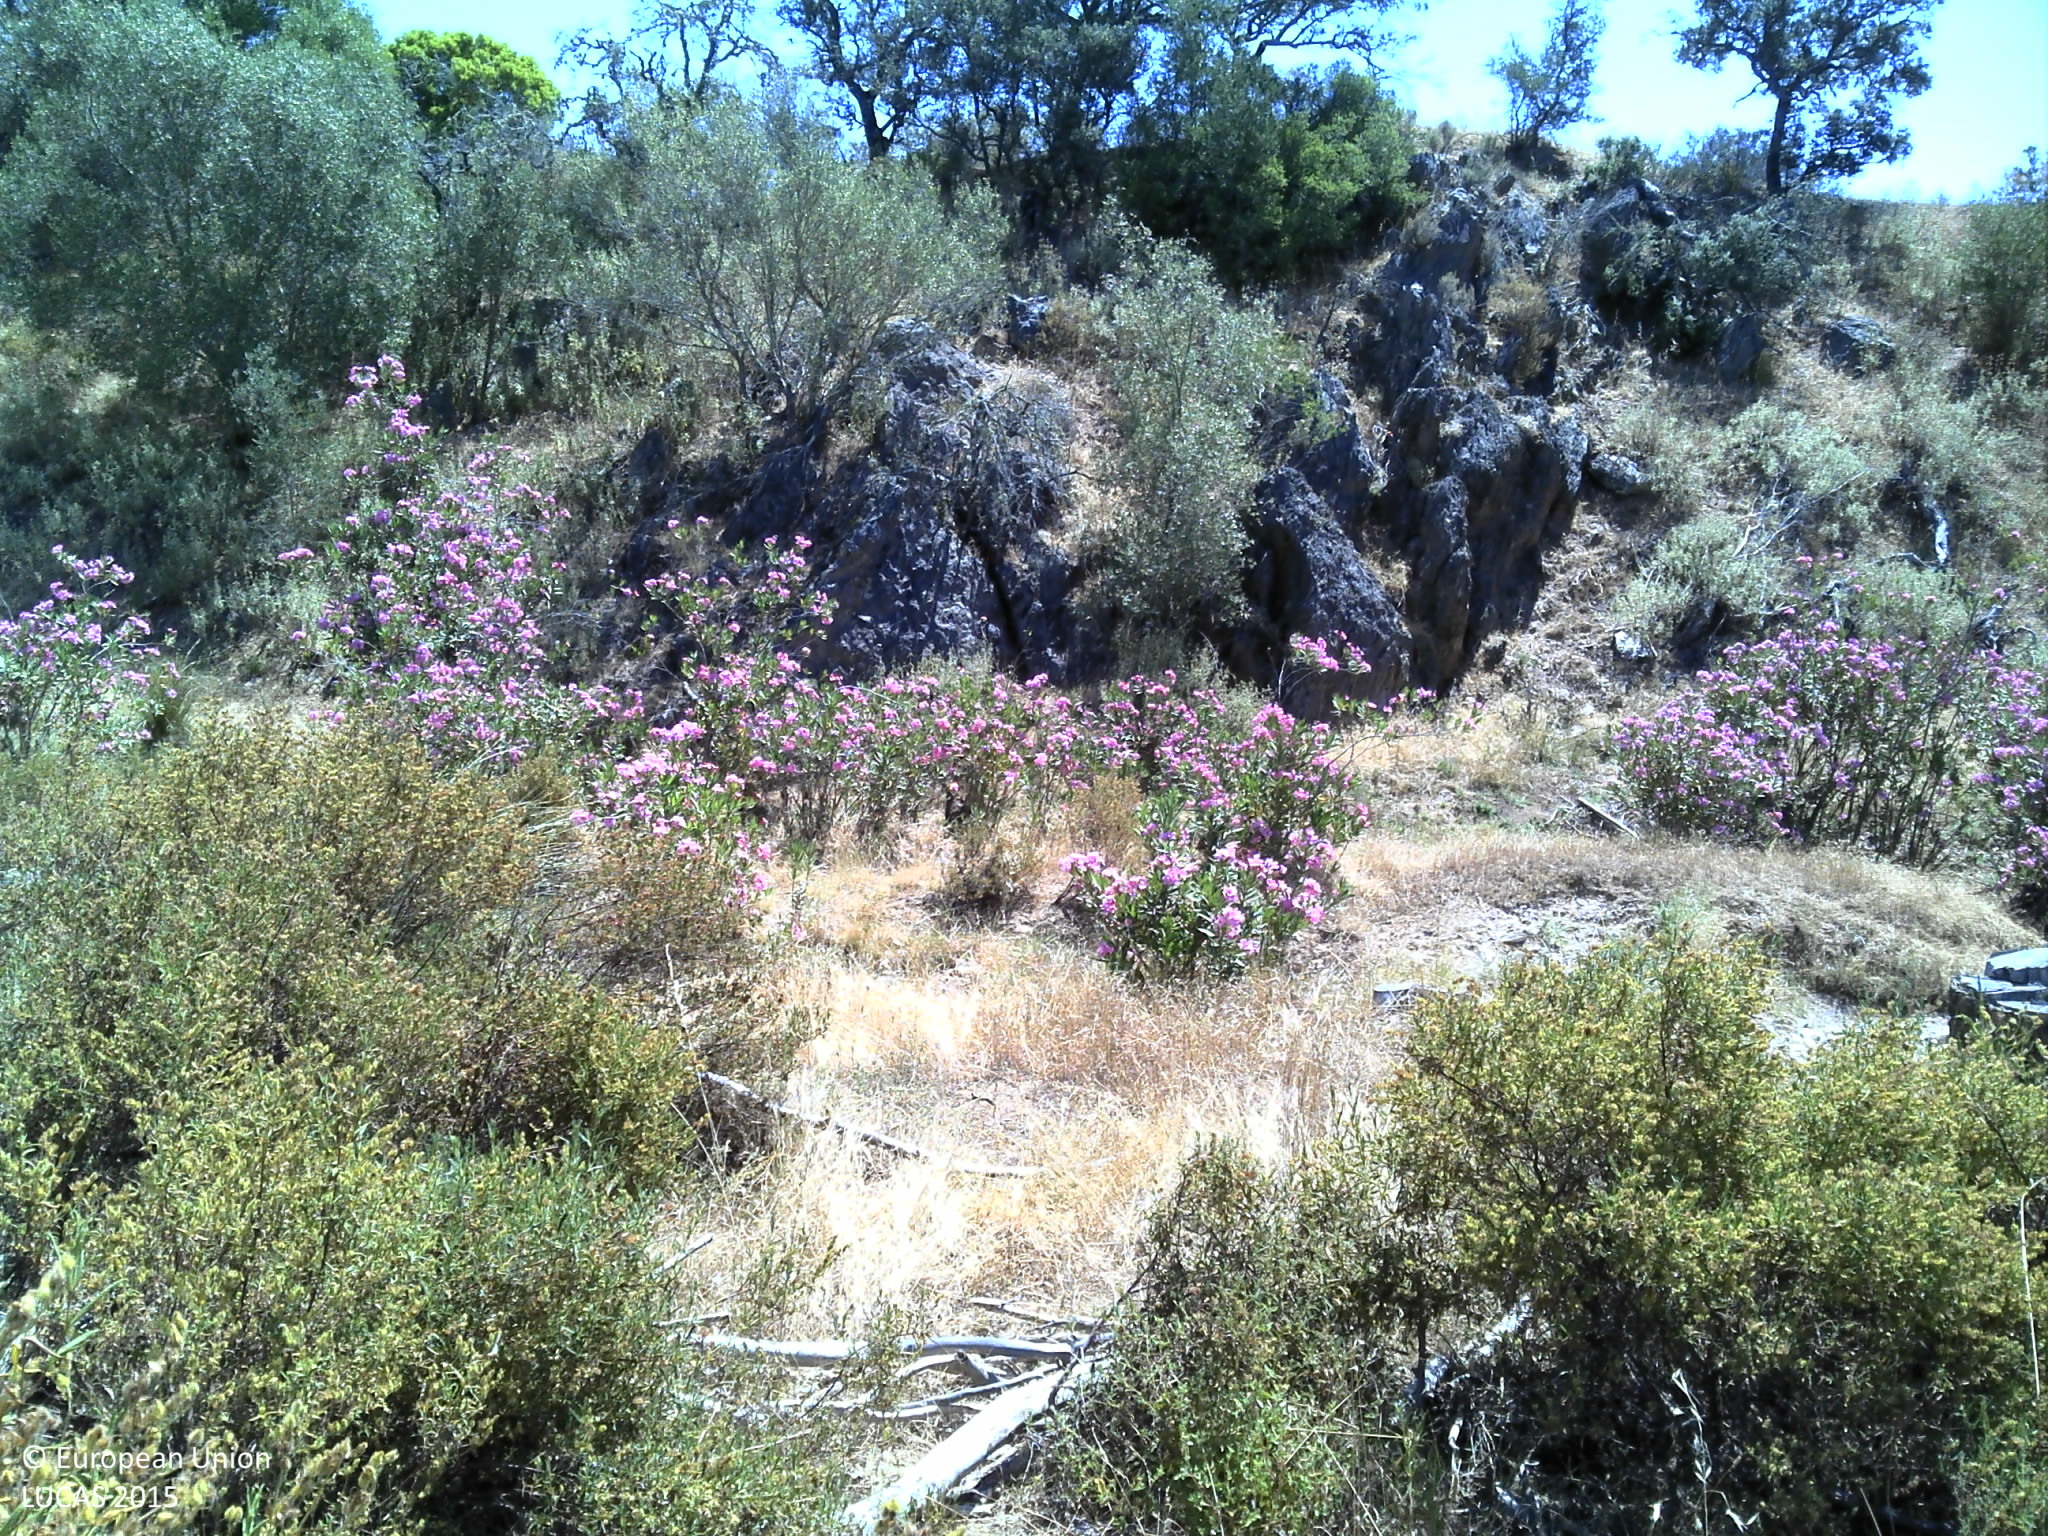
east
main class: Shrubland
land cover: Shrubland without tree cover
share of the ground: 50 - 75 %
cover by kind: shrubs 100 %
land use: Semi-natural and natural areas not in use
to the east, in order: Shrubland without tree cover; Rivers and streams; Shrubland with sparse tree cover; Rock outcrops; Broadleaved woodland; Grassland with sparse tree/shrub cover; Grassland without tree/shrub cover; Shrubland without tree cover; Shrubland with sparse tree cover; Shrubland without tree cover; Grassland without tree/shrub cover; Shrubland without tree cover; Rivers and streams; Shrubland with sparse tree cover; Rivers and streams; Shrubland without tree cover
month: June
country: PT
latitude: 37.6948
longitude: -7.5359
